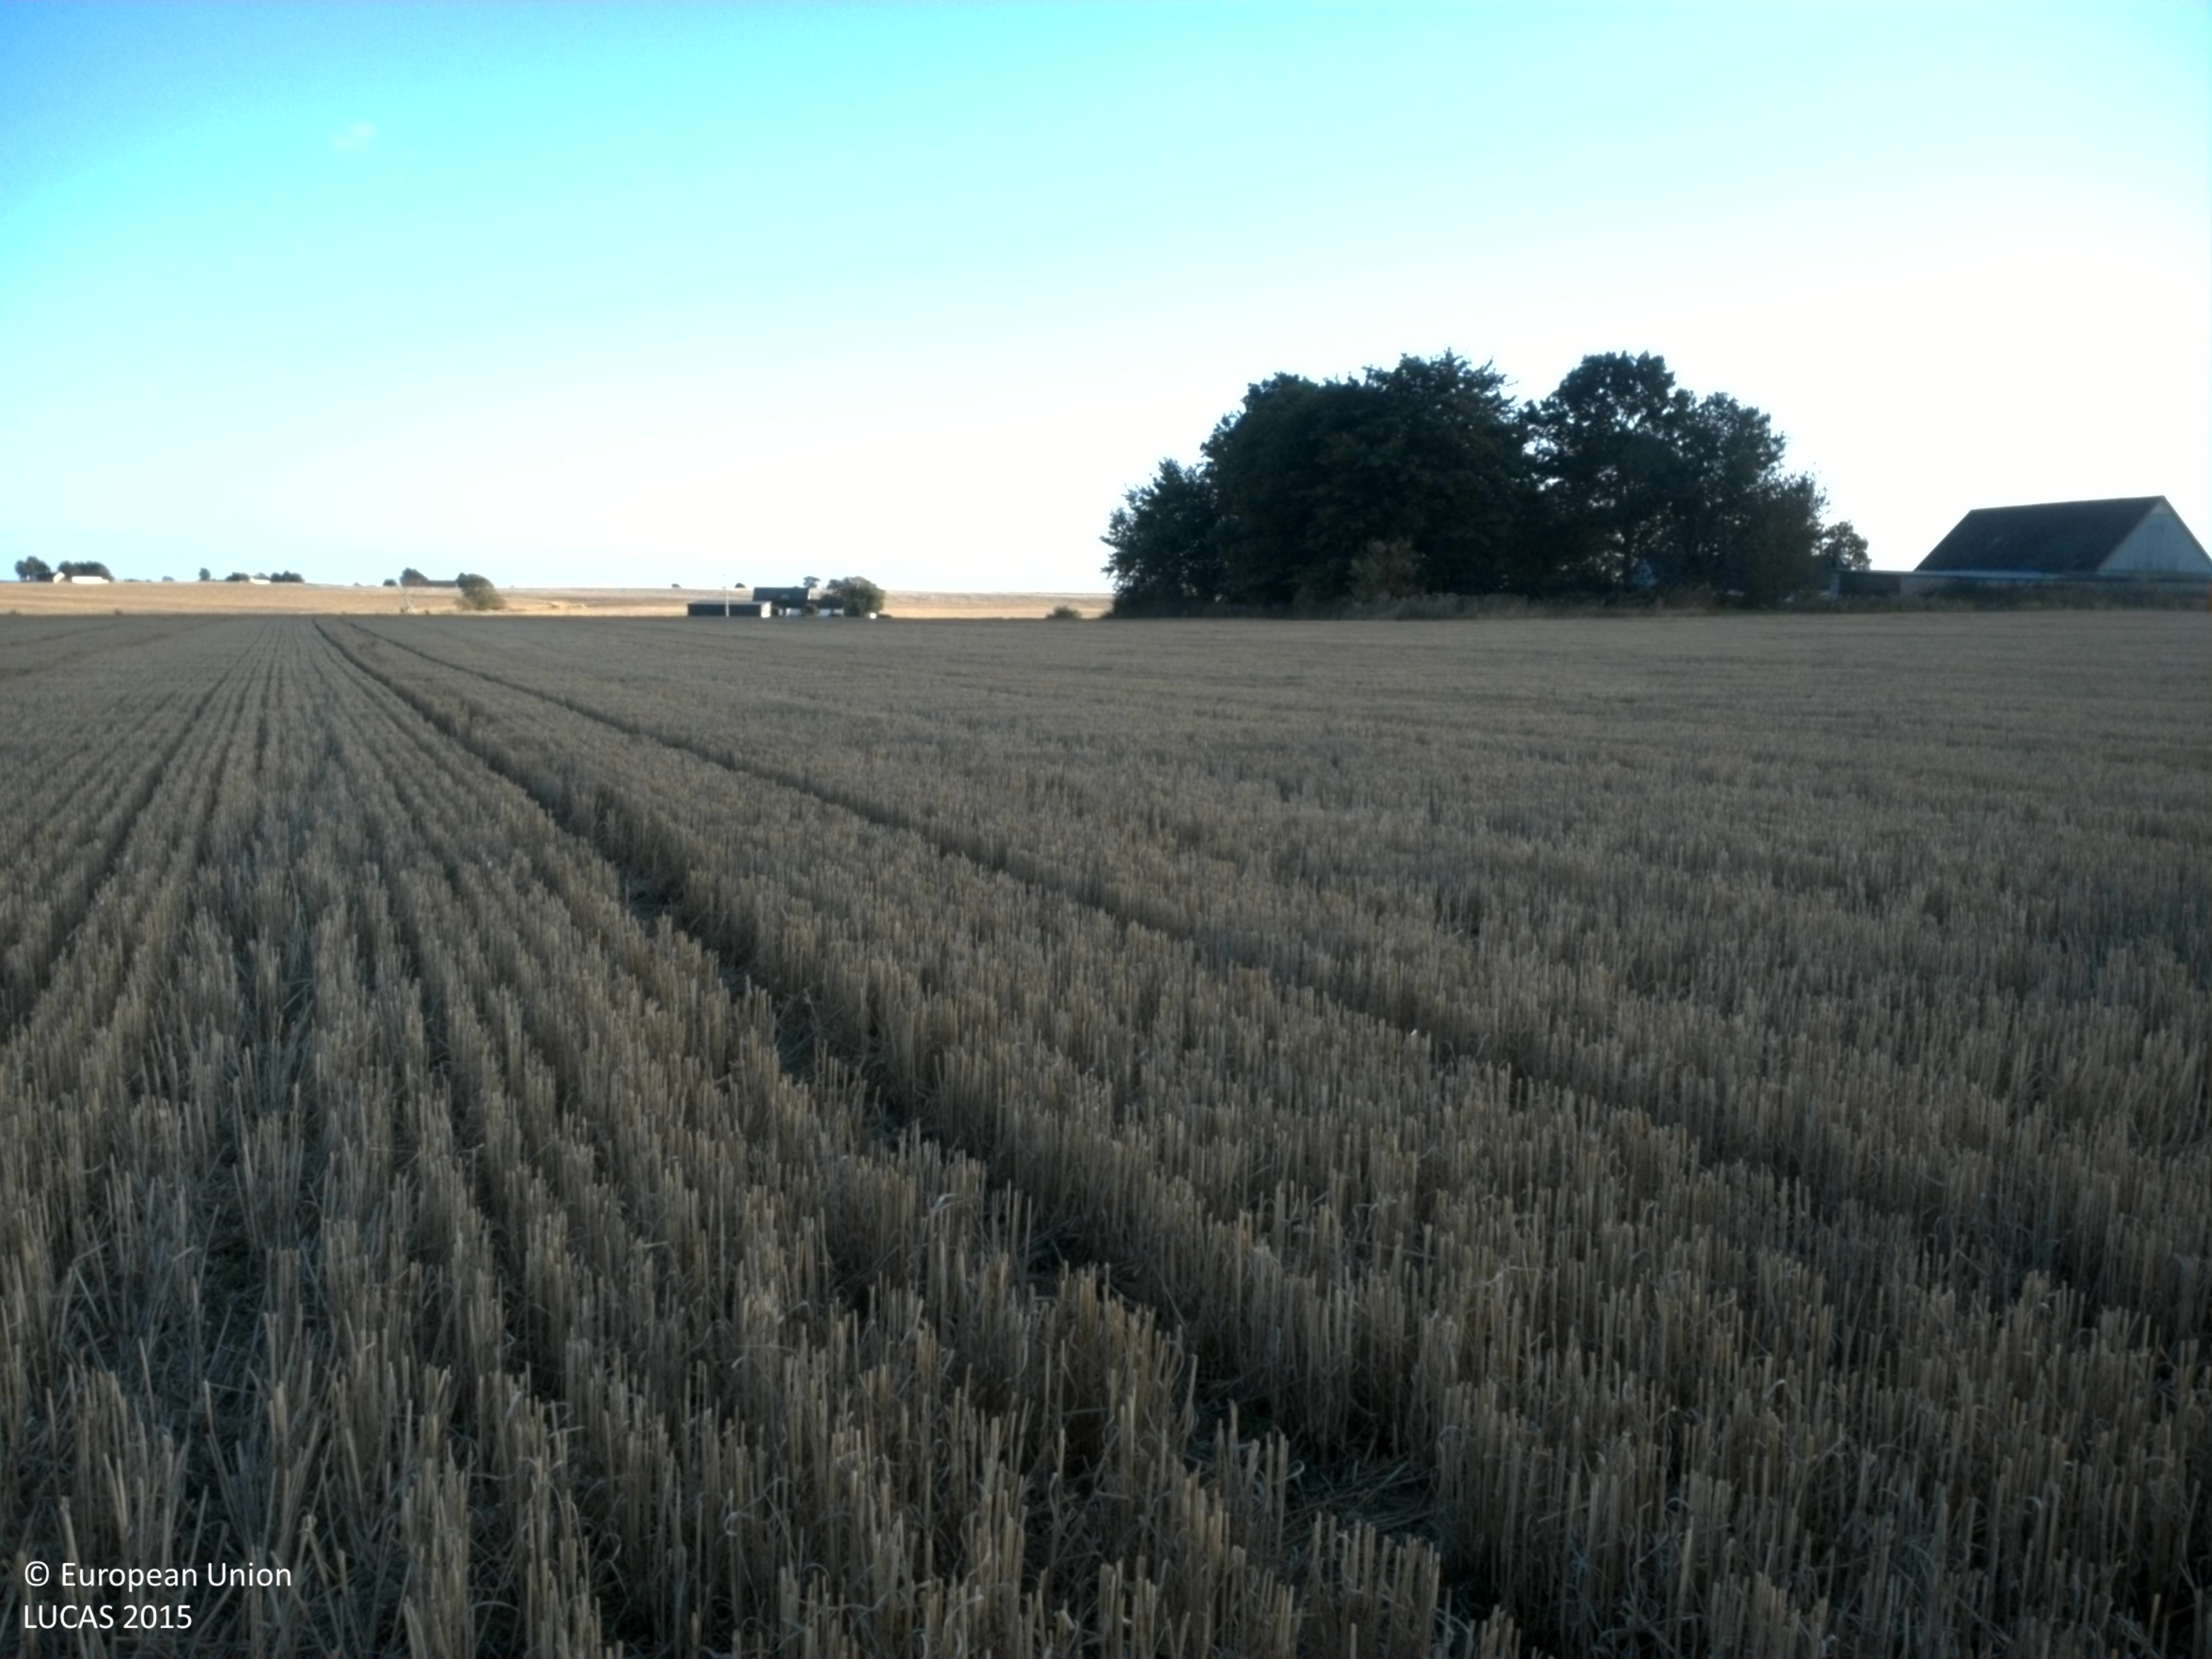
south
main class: Cropland
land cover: Common wheat
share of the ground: 25 - 50 %
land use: Agriculture (excluding fallow land and kitchen gardens)
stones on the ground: < 10 %
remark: Harvested field
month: September
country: SE
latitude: 55.4765
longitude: 14.0330
